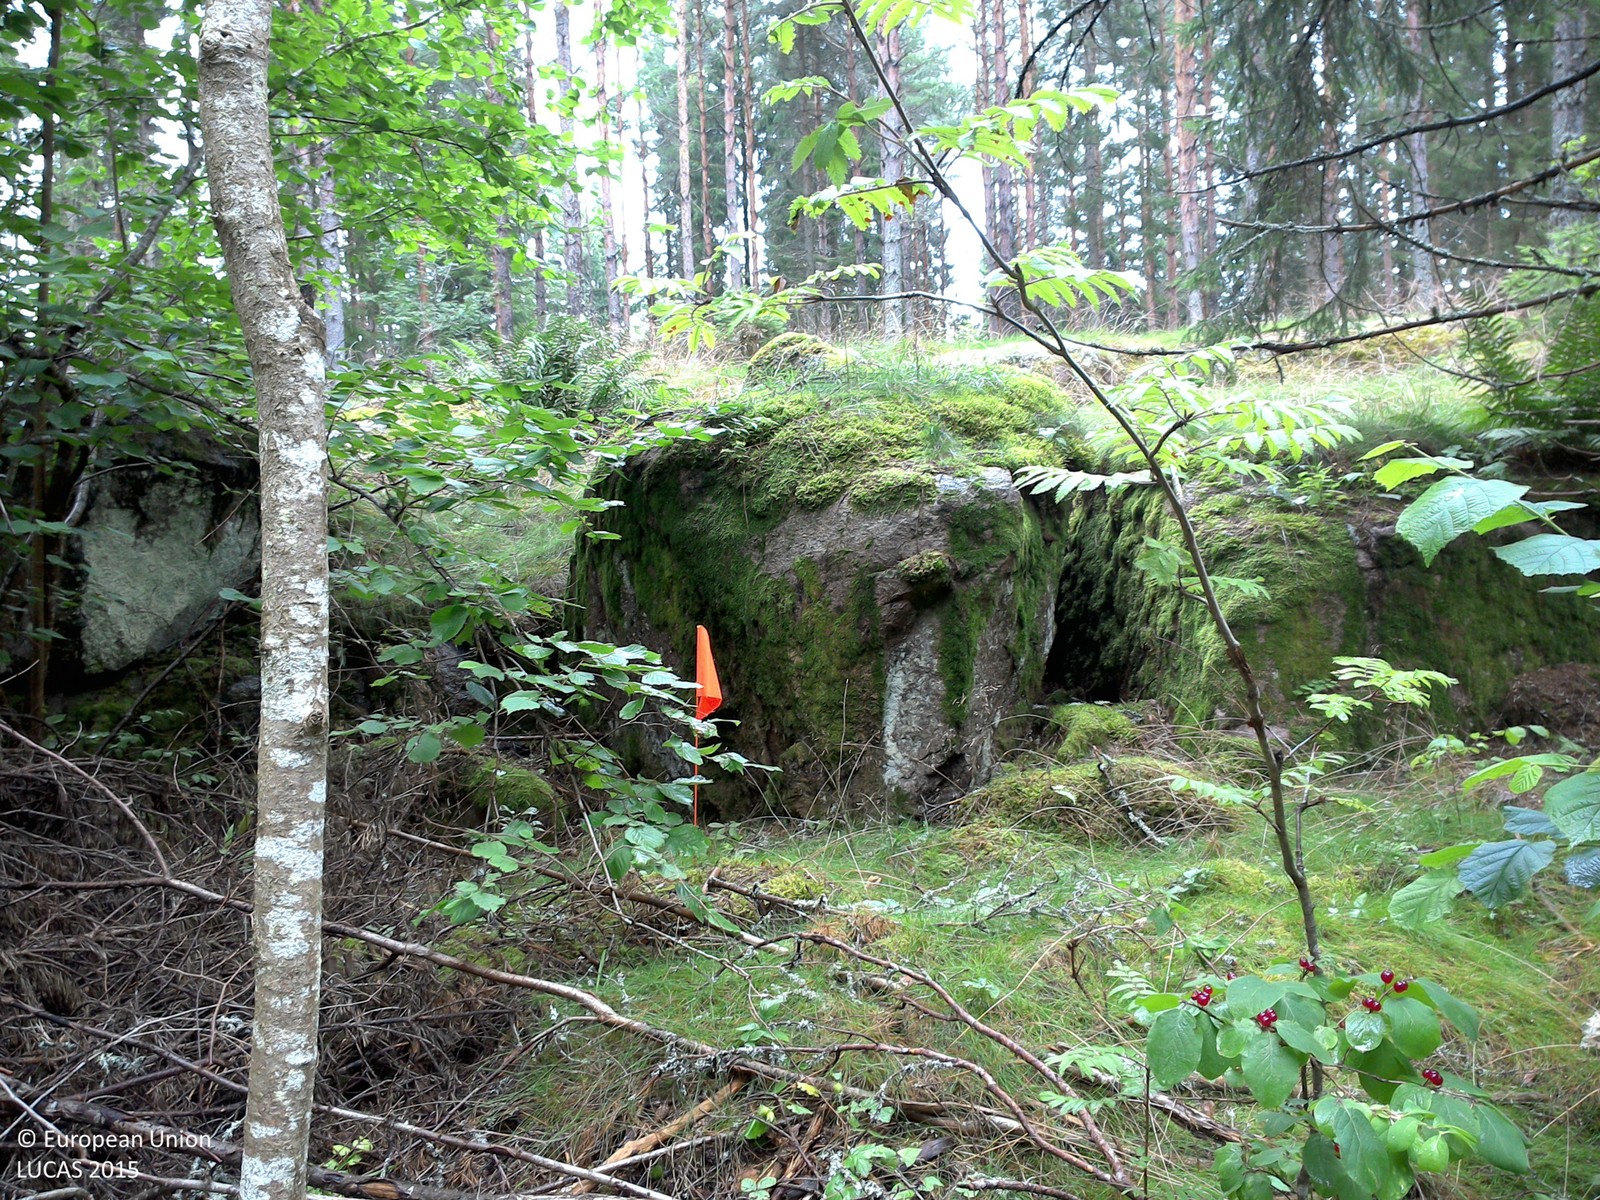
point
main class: Woodland
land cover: Spruce dominated coniferous woodland
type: boreal forest
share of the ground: 50 - 75 %
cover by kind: coniferous forest trees 60 %, herbaceous plants 25 %, lichens and mosses 10 %, broadleaved forest trees 5 %
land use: Forestry
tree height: > 5 m
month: August
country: SE
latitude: 58.2375
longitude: 15.3940
